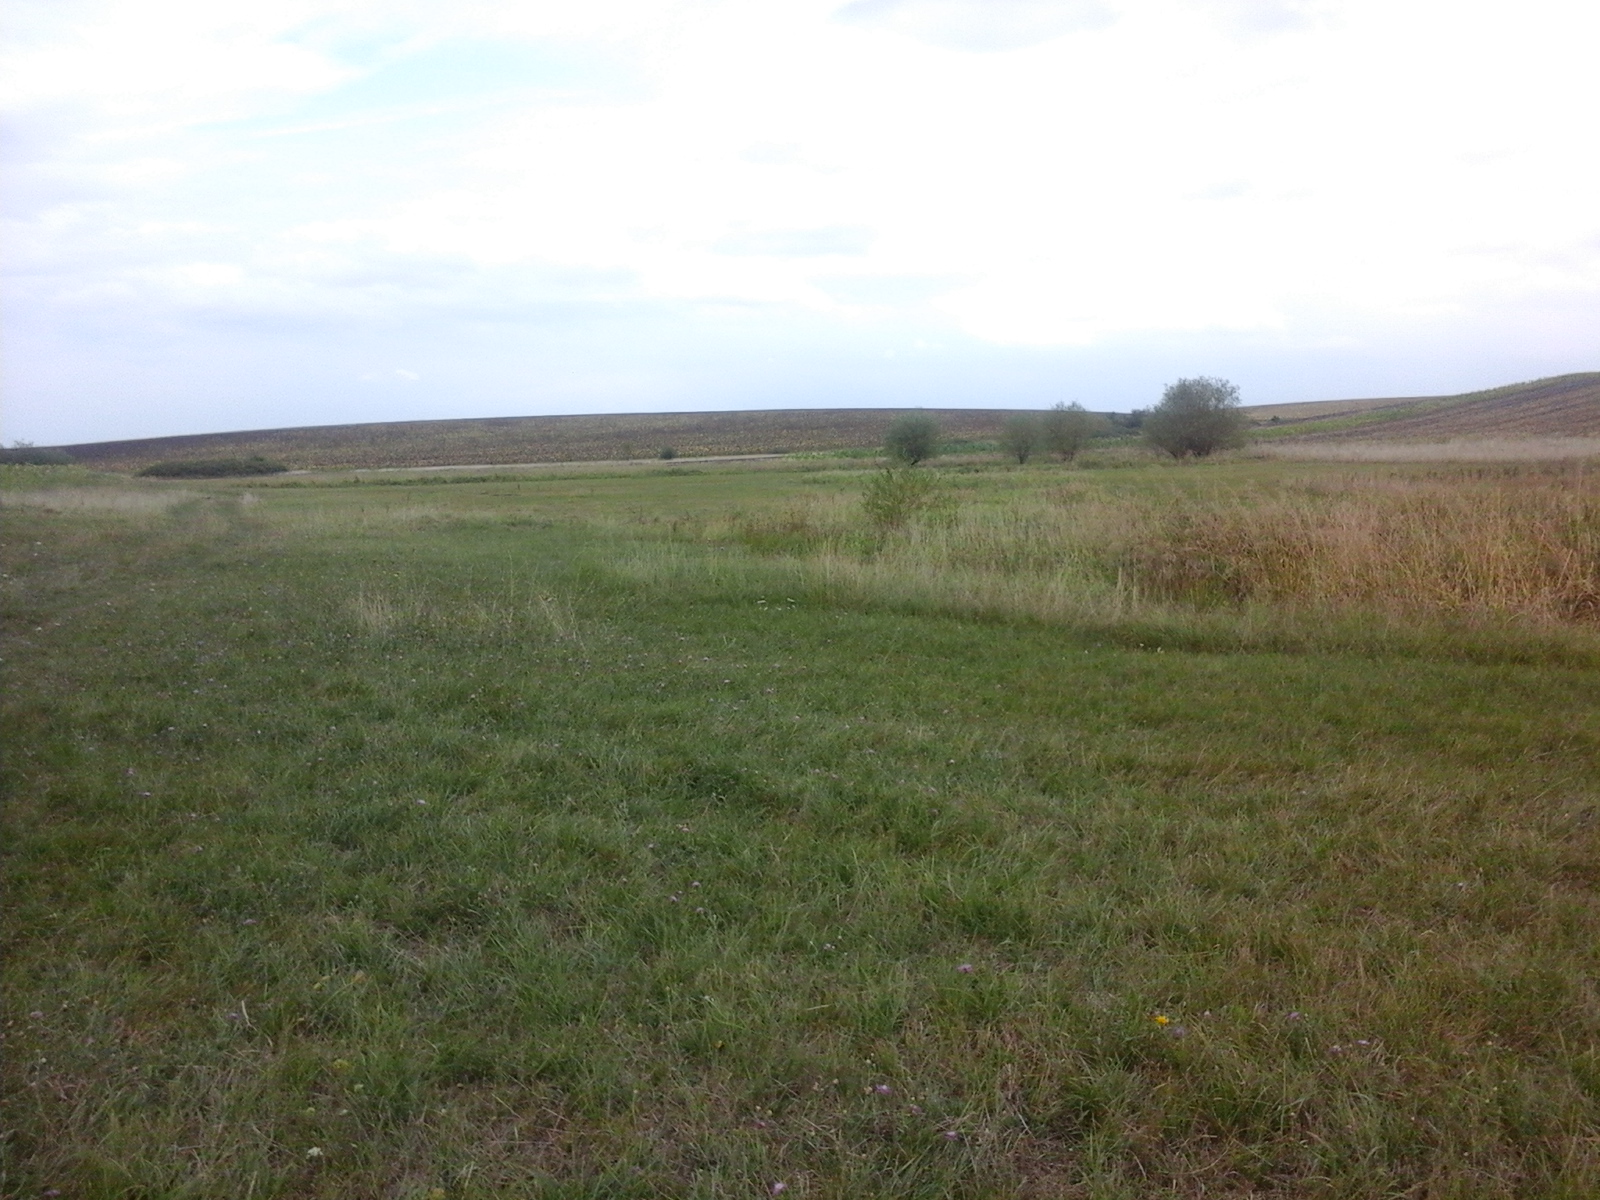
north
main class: Grassland
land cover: Grassland without tree/shrub cover
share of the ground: > 75 %
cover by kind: herbaceous plants 100 %
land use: Agriculture (excluding fallow land and kitchen gardens)
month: August
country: RO
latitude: 45.5172
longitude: 21.4378
